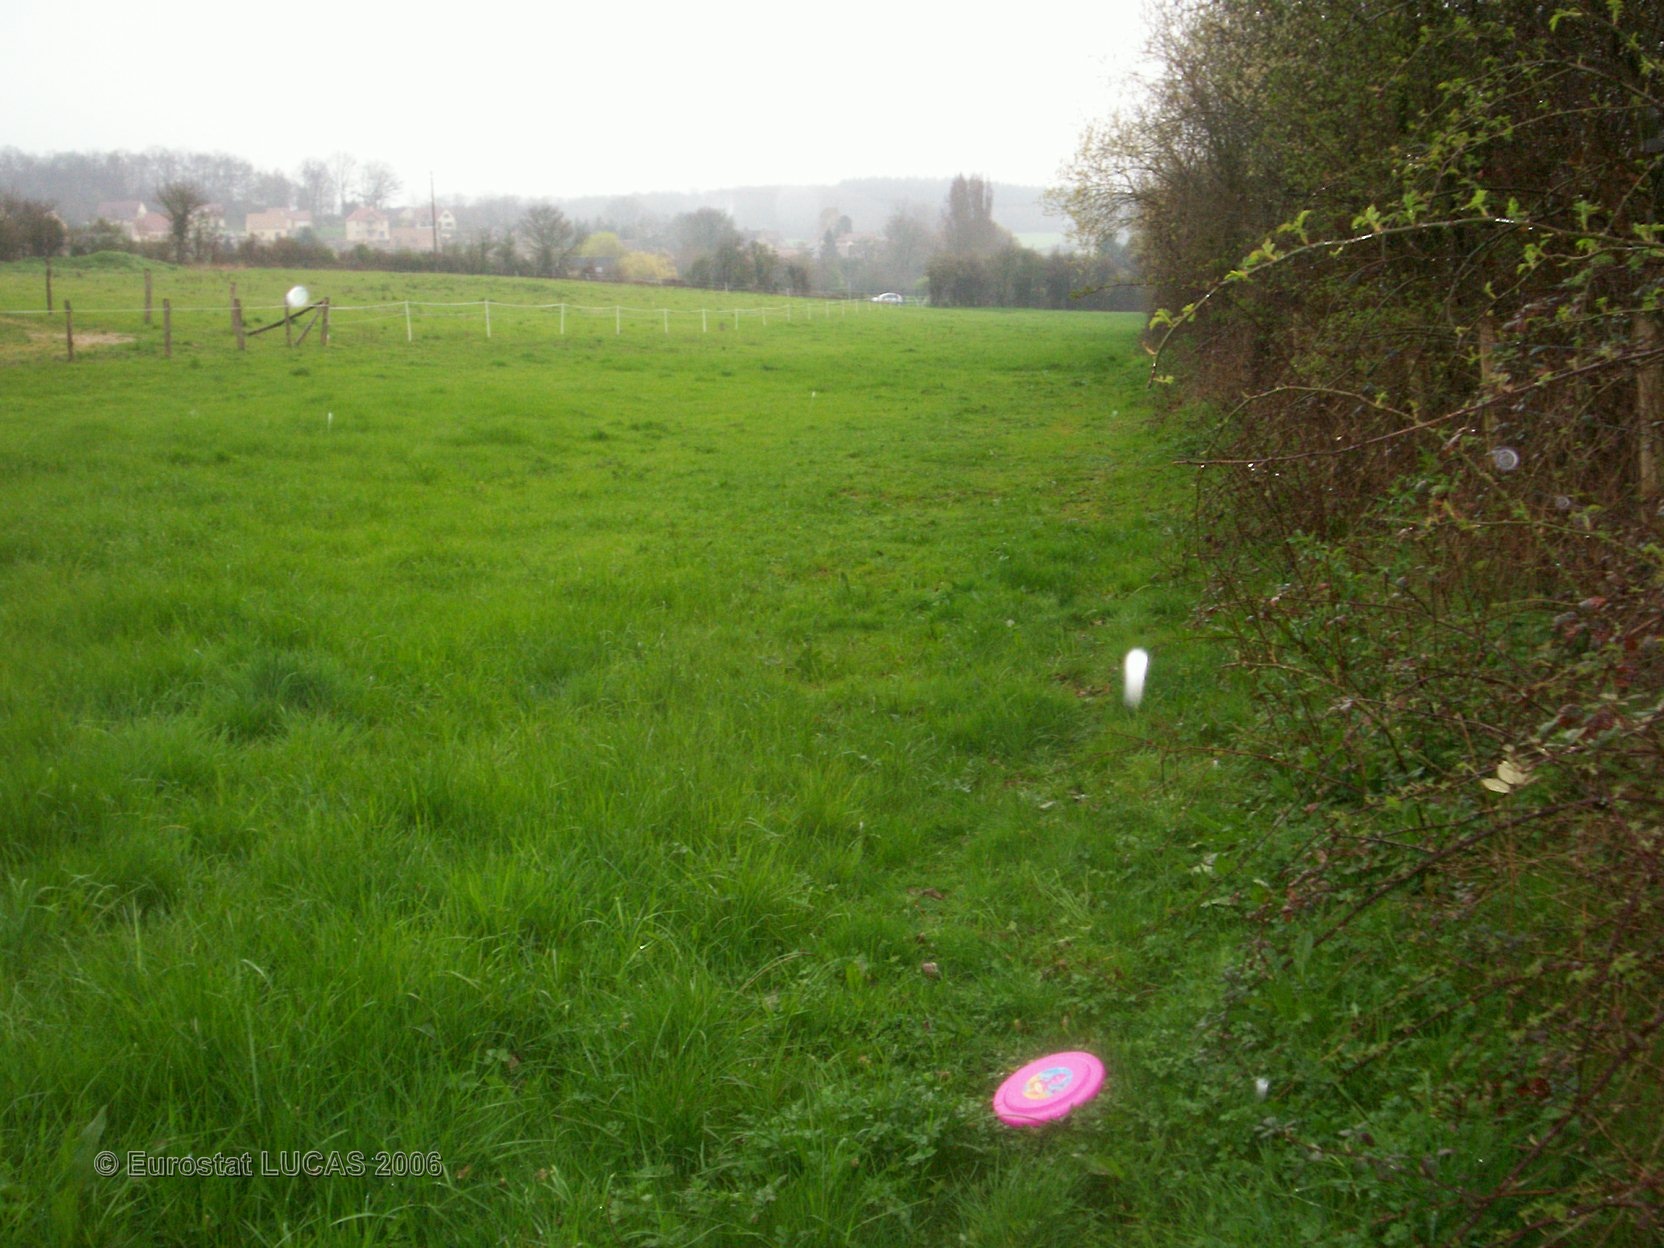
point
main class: Grassland
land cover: Grassland without tree/shrub cover
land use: Agriculture (excluding fallow land and kitchen gardens)
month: April
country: FR
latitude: 48.3575
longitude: 0.1064
